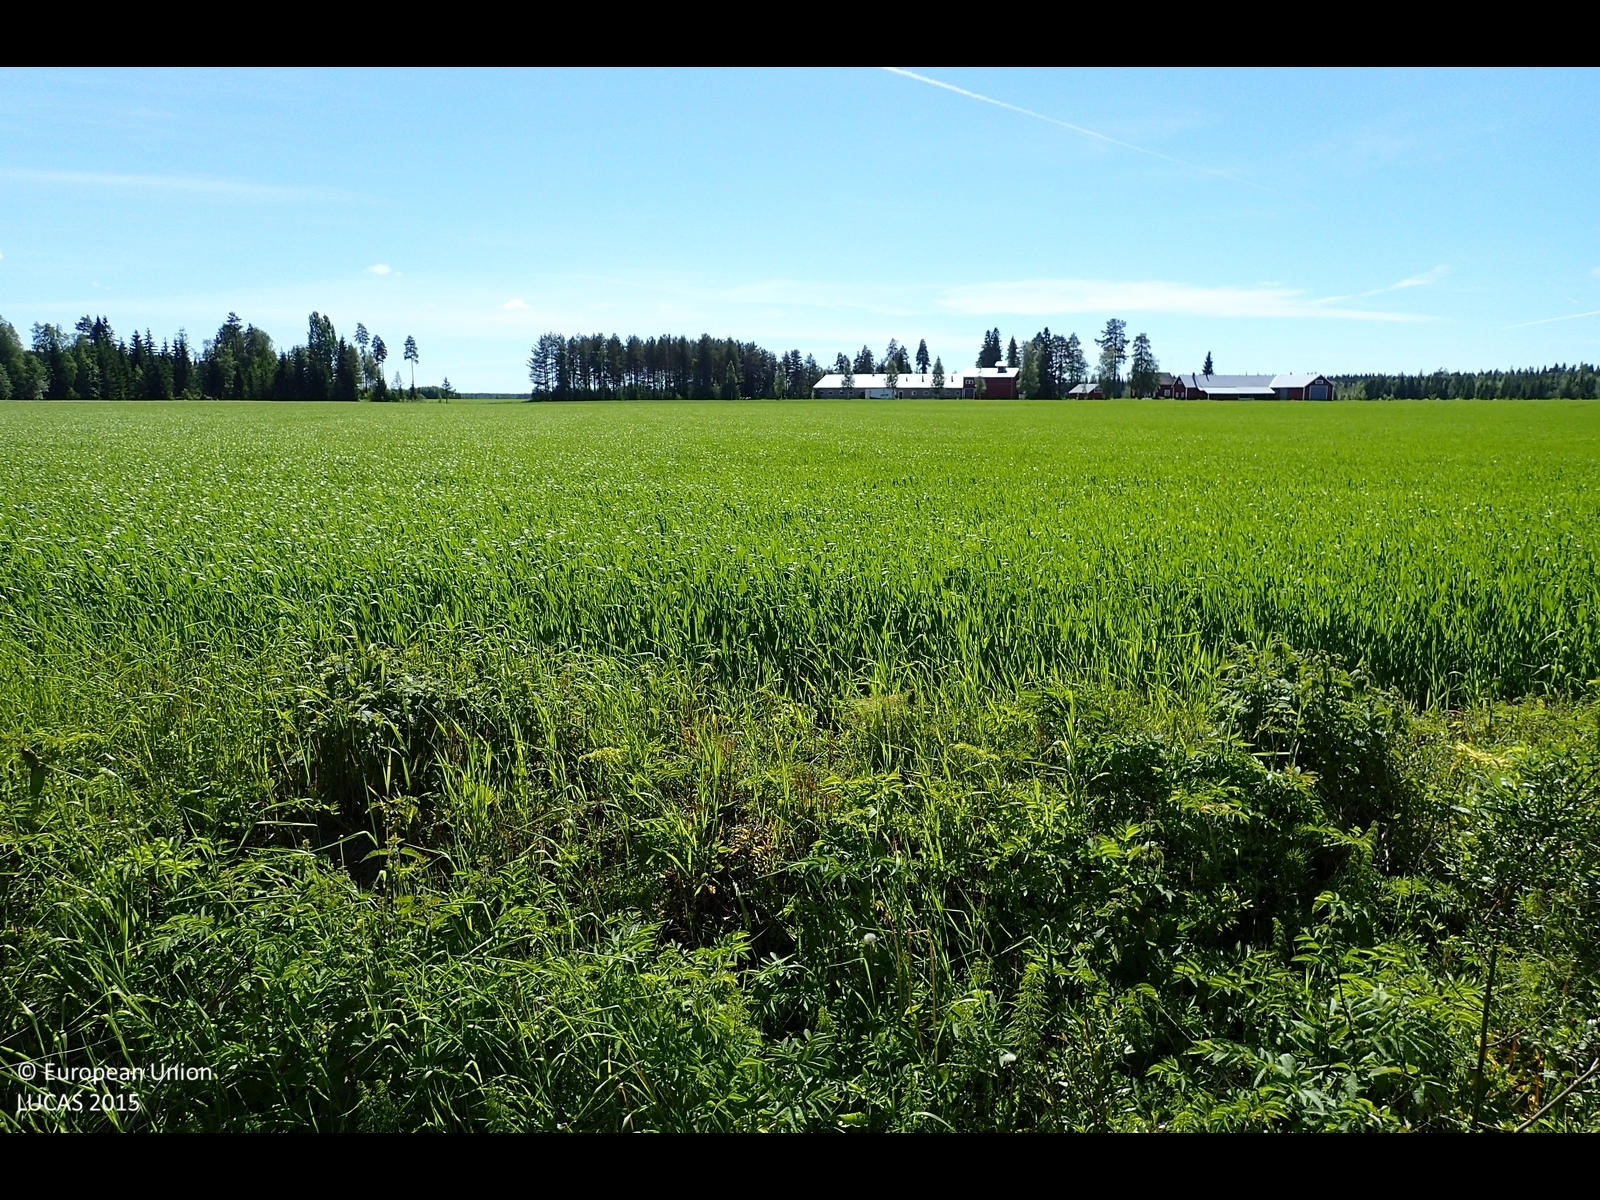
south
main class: Cropland
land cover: Barley
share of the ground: > 75 %
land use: Agriculture (excluding fallow land and kitchen gardens)
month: July
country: FI
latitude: 62.5183
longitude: 21.7198
